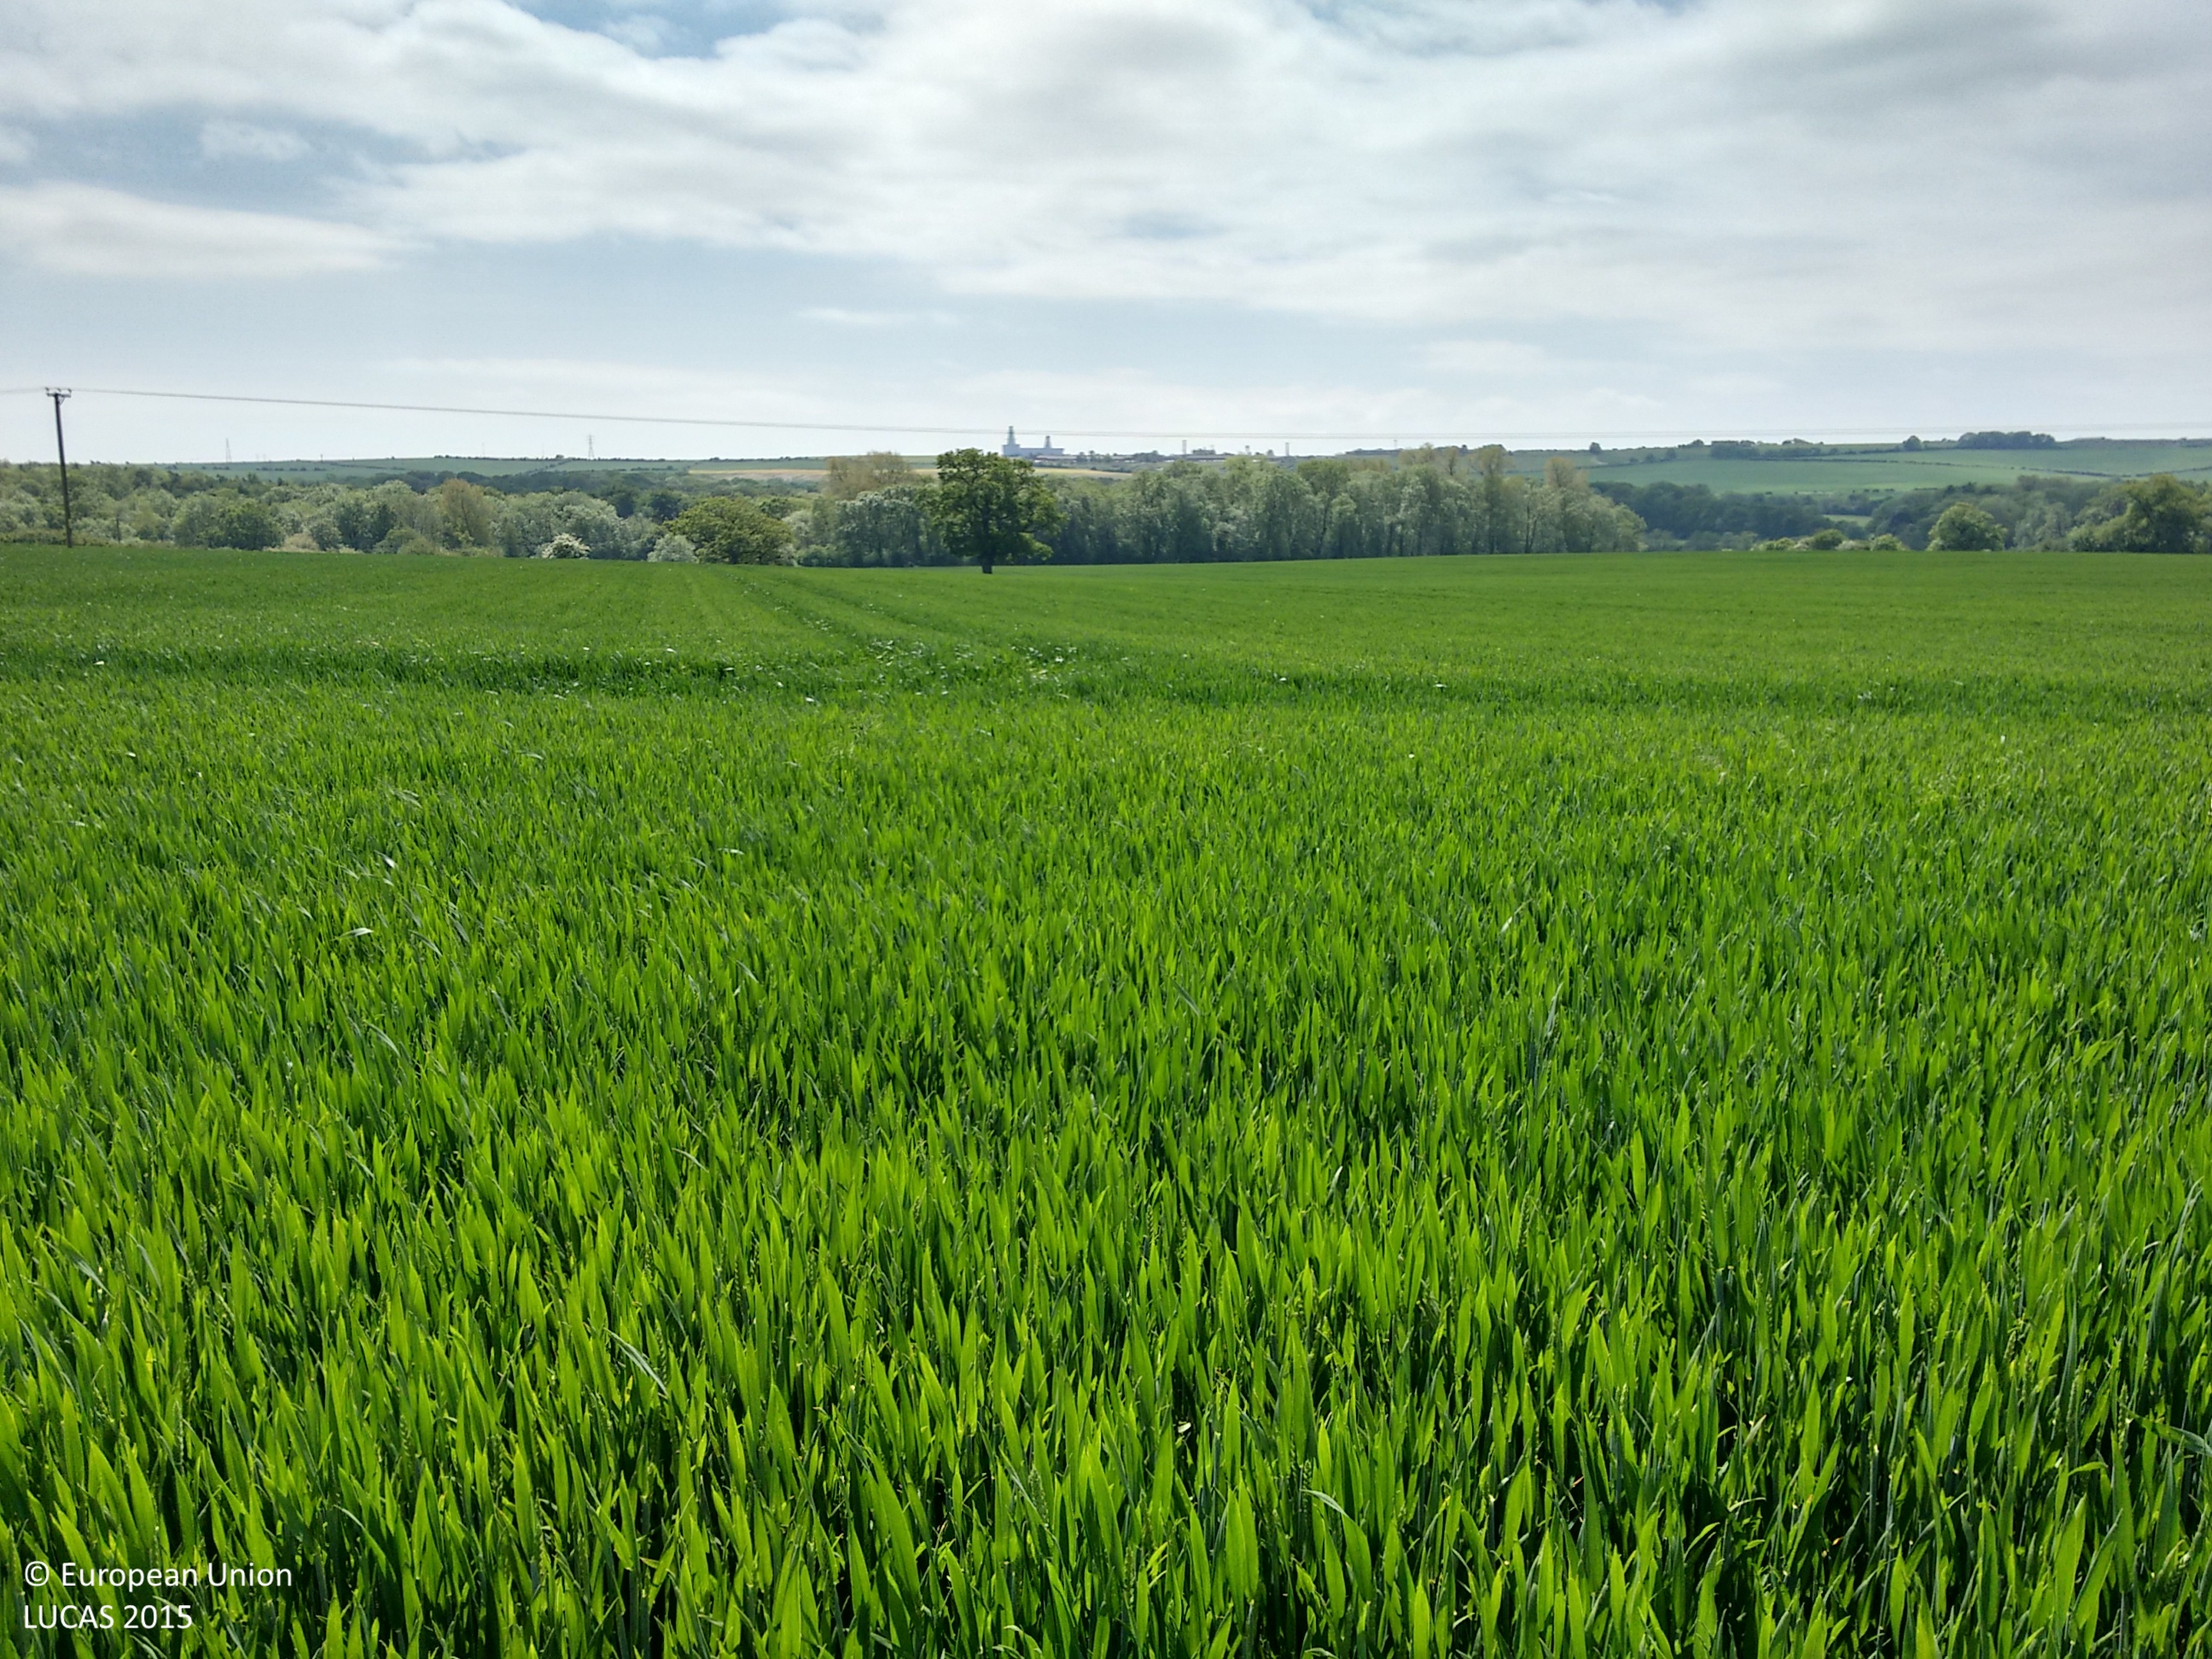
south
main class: Cropland
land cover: Common wheat
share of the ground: > 75 %
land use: Agriculture (excluding fallow land and kitchen gardens)
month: May
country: GB
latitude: 50.8760
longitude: -1.0880
